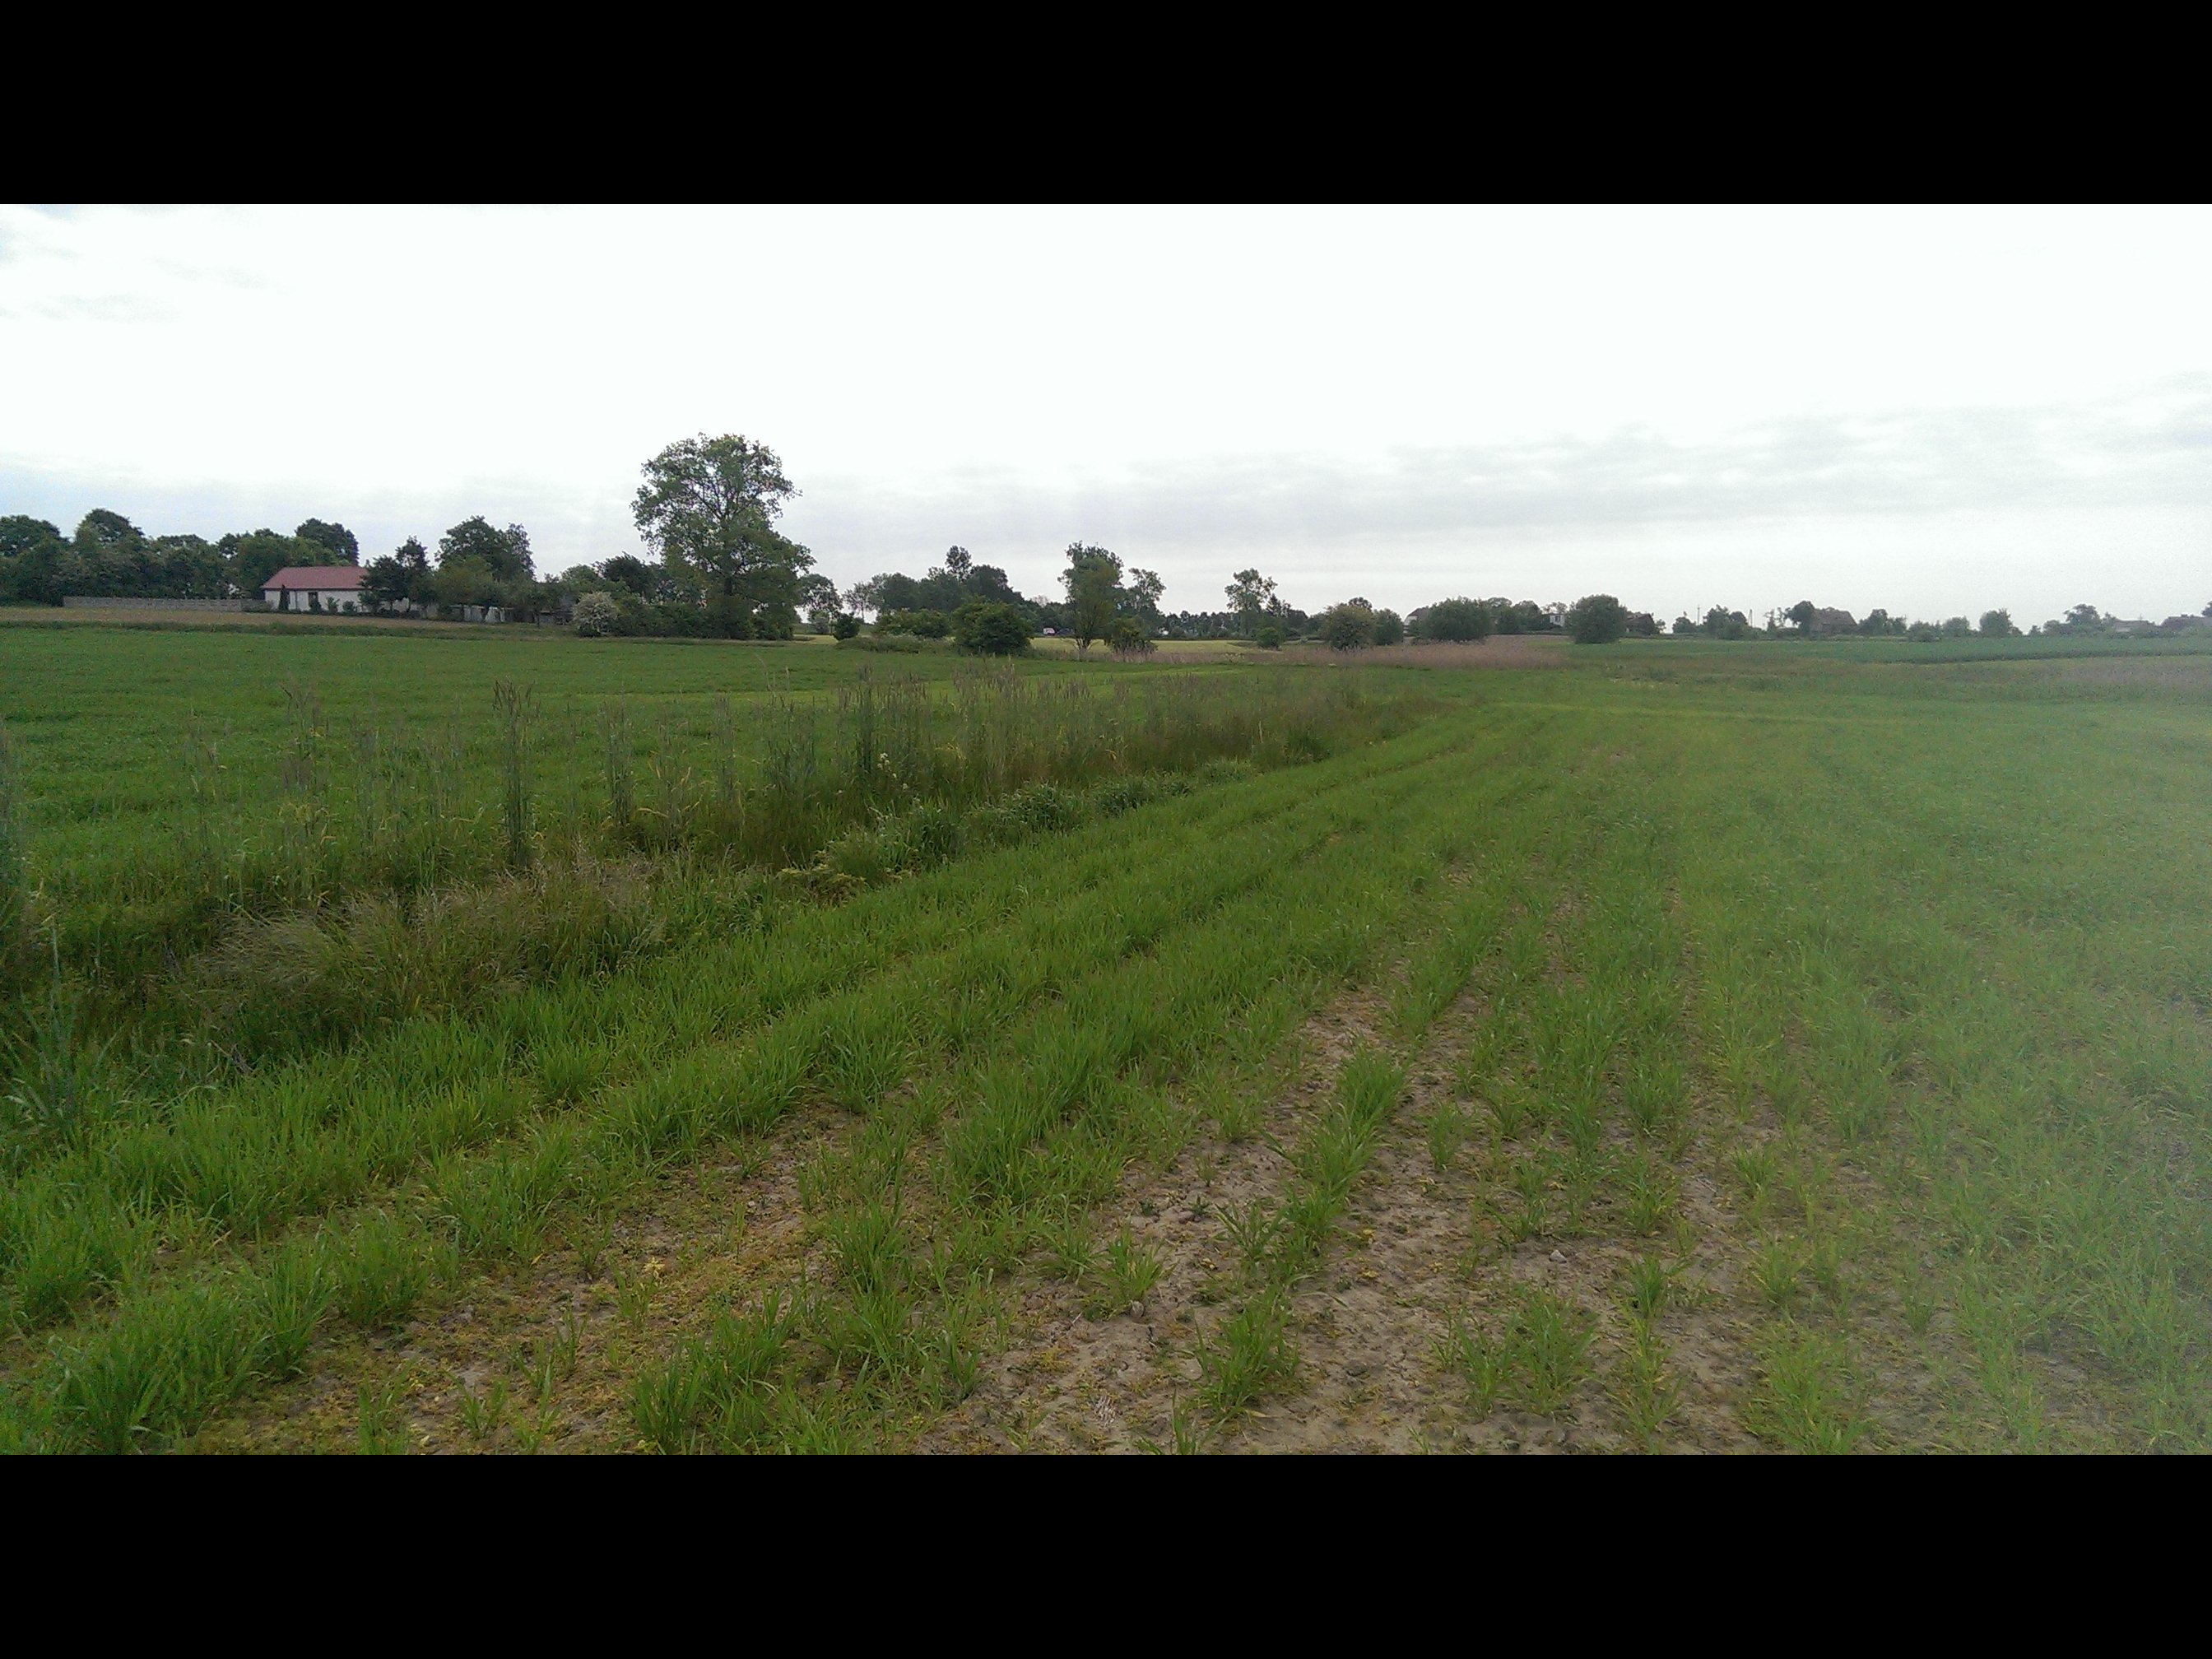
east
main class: Cropland
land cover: Barley
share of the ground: > 75 %
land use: Agriculture (excluding fallow land and kitchen gardens)
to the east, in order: Barley; Ditches and canals; Barley; Tracks; Grass margins; Sugar beet; Artificial constructions in urban areas
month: May
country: PL
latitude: 52.4094
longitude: 16.2838
